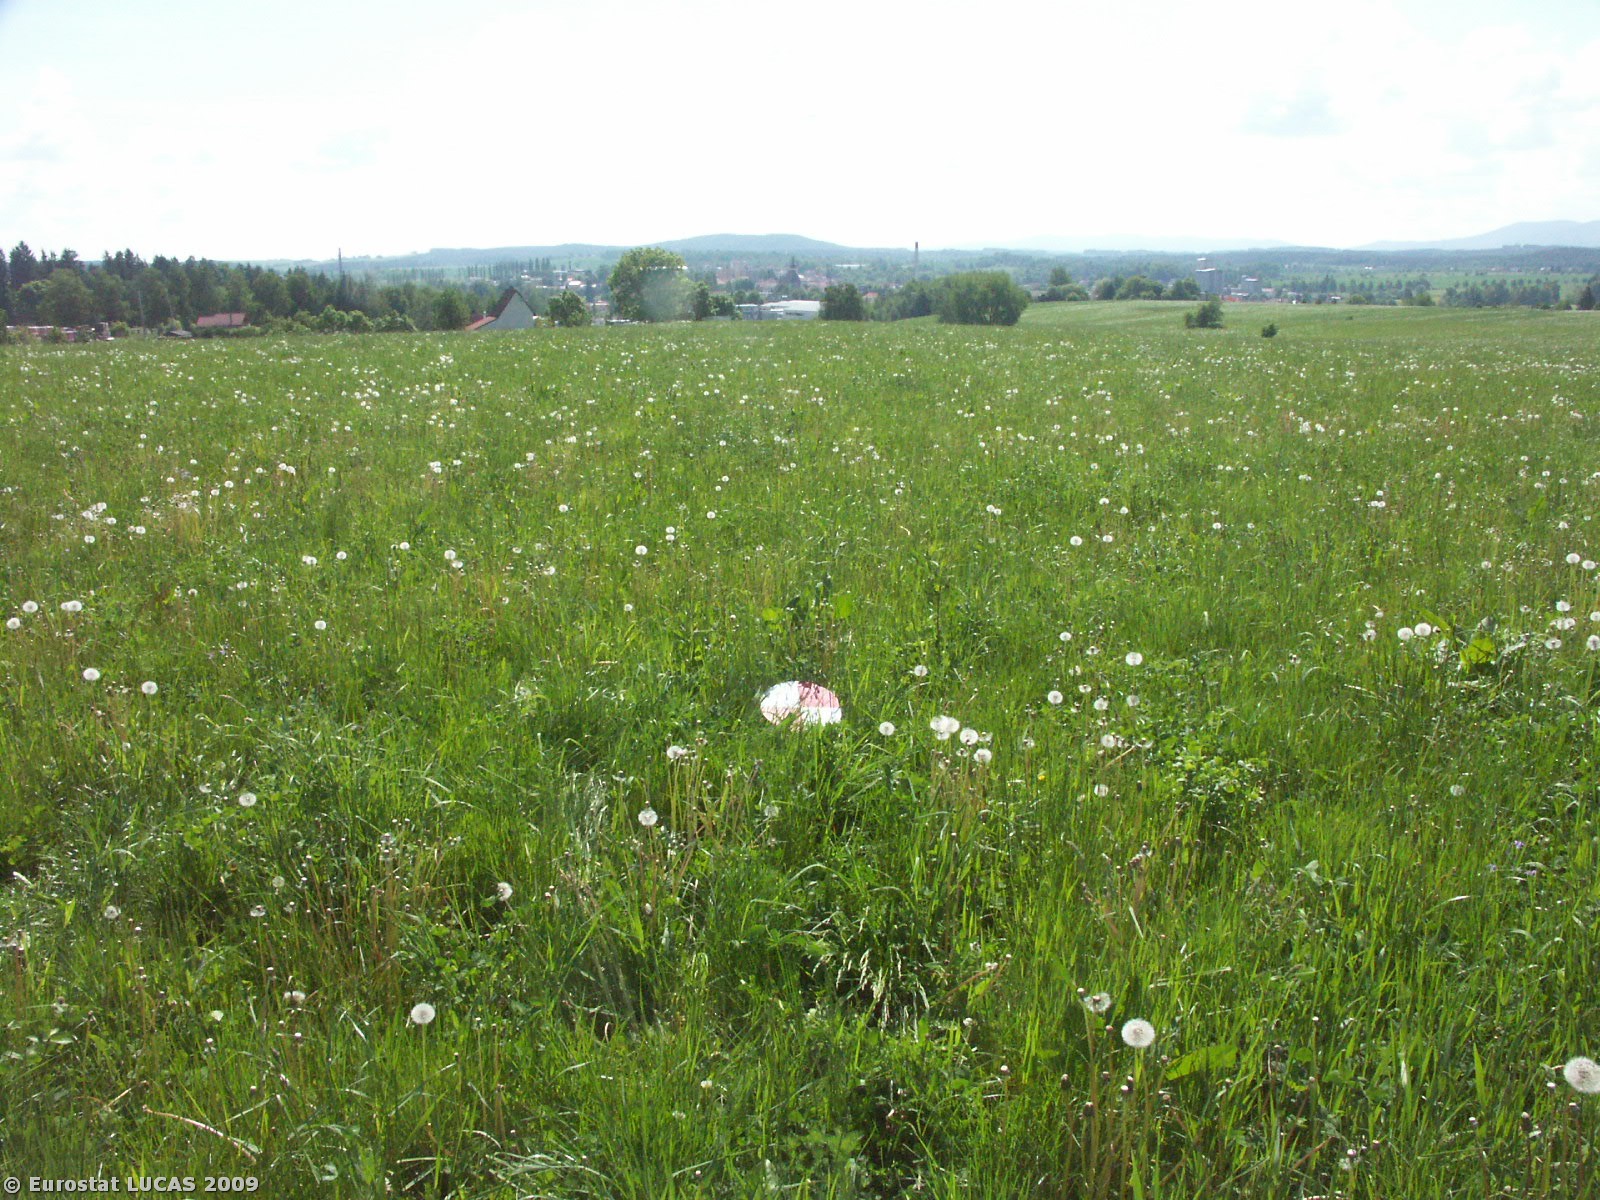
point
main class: Grassland
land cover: Grassland without tree/shrub cover
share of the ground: > 75 %
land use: Agriculture (excluding fallow land and kitchen gardens)
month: May
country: CZ
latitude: 48.8476
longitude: 14.6209
